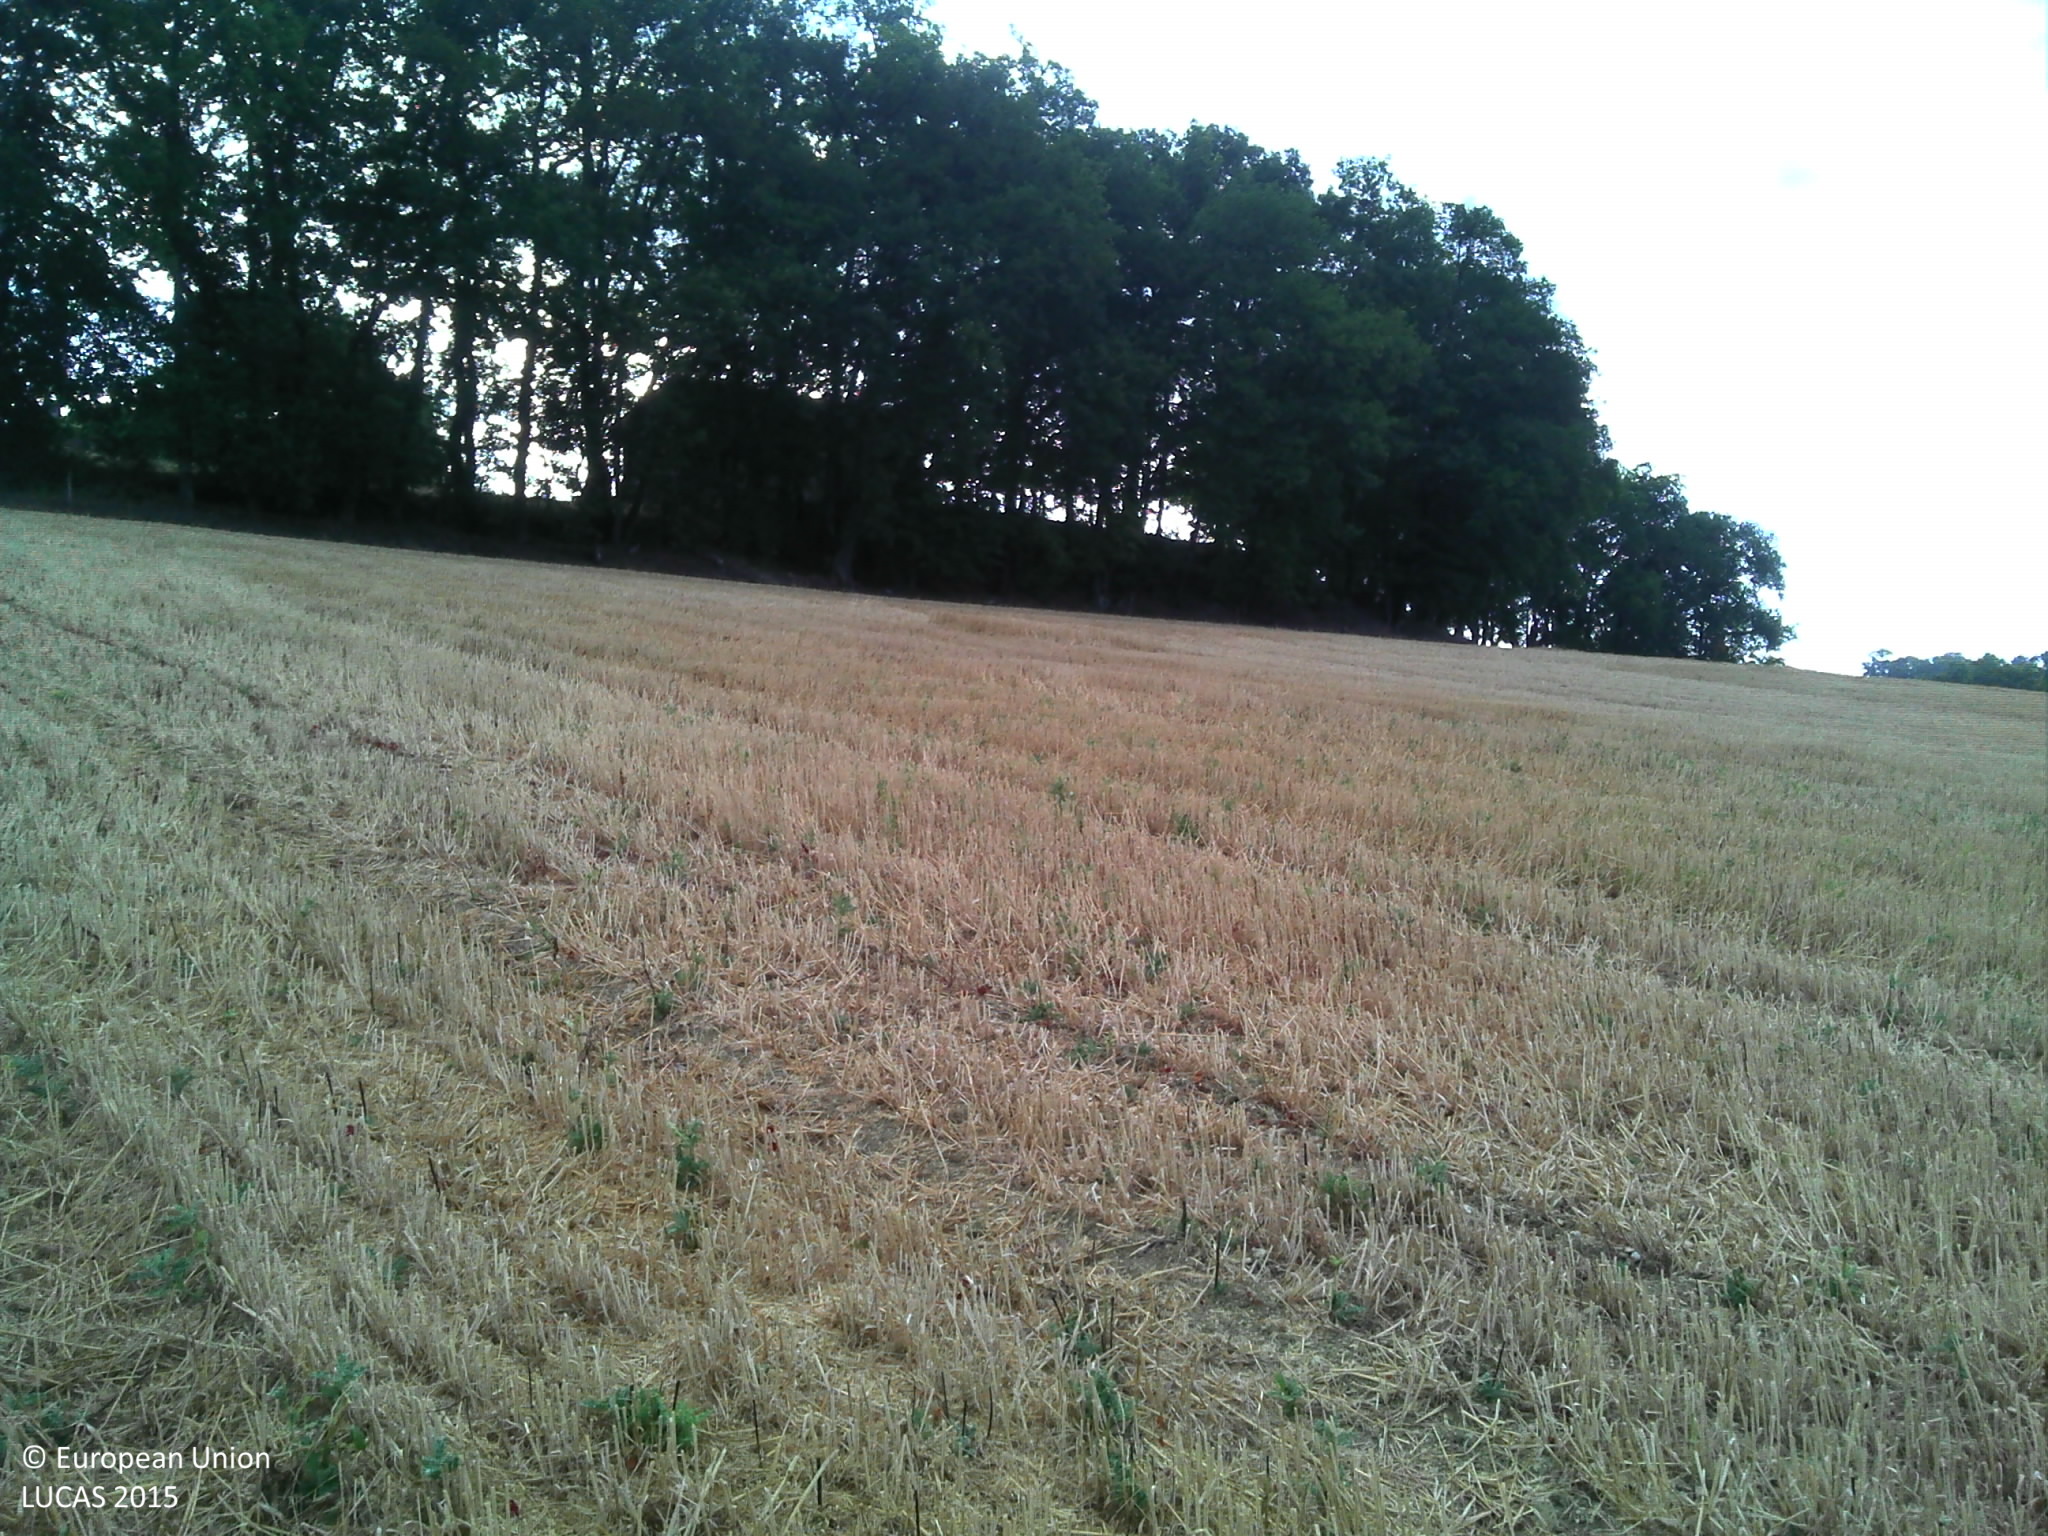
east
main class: Cropland
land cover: Common wheat
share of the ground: > 75 %
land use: Agriculture (excluding fallow land and kitchen gardens)
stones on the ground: < 10 %
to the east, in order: Common wheat; Fences; Broadleaved woodland; Grassland without tree/shrub cover; Tracks; Grassland without tree/shrub cover; Fences; Grassland without tree/shrub cover
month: July
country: FR
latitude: 44.3225
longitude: 0.6022
